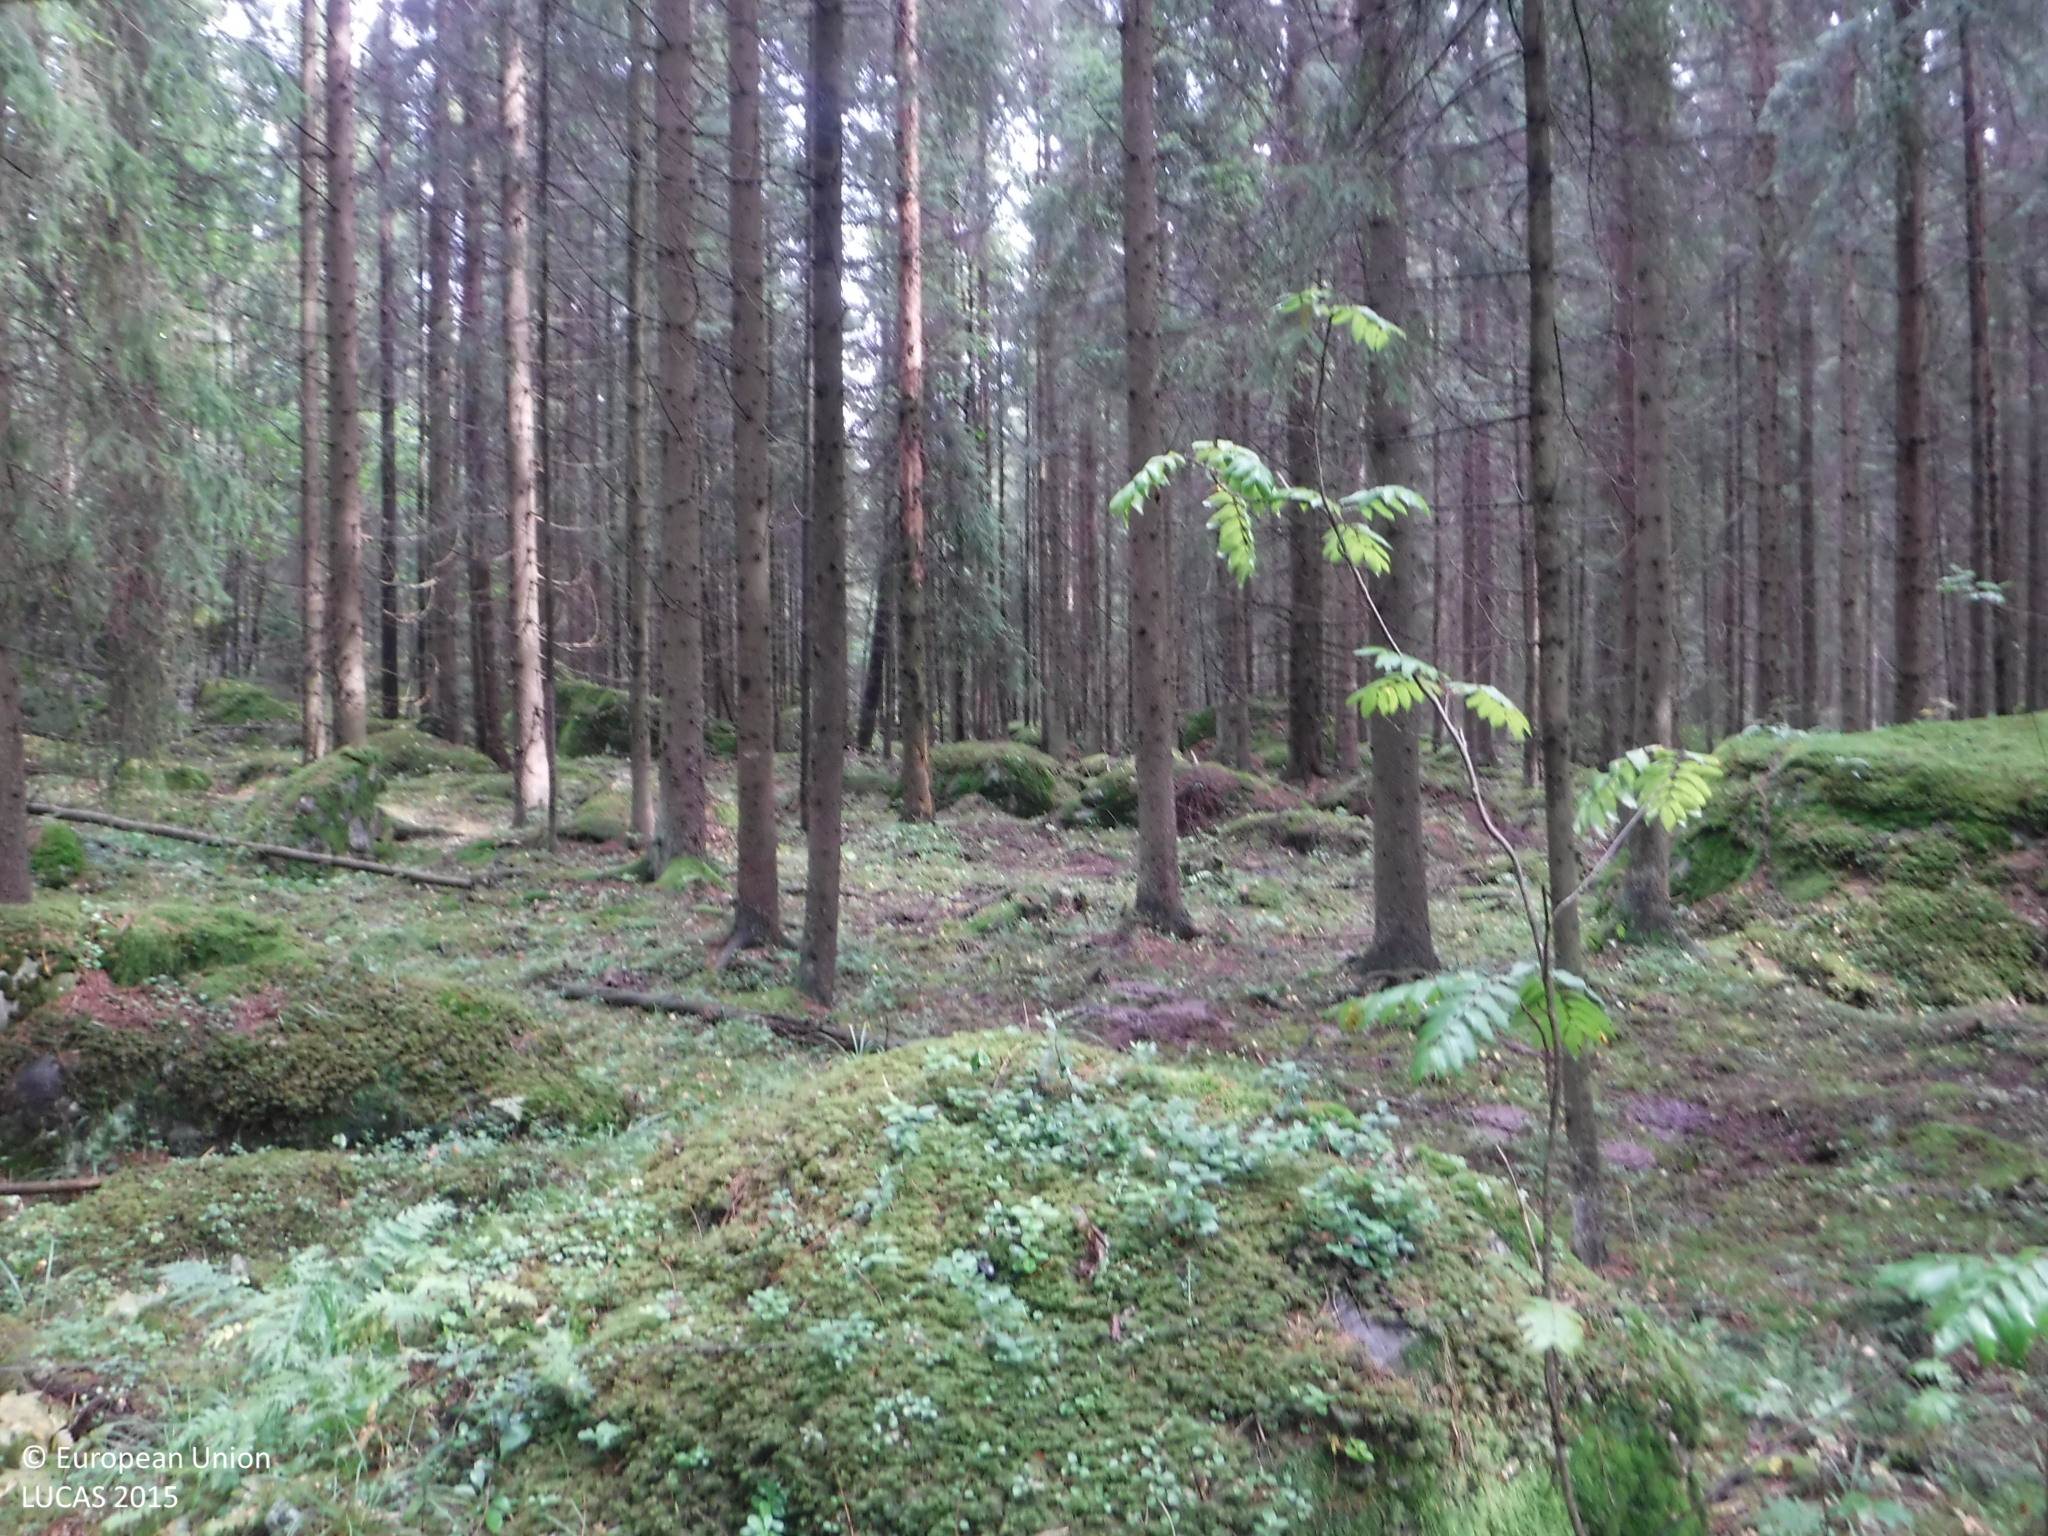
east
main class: Woodland
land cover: Spruce dominated coniferous woodland
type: boreal forest
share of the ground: 50 - 75 %
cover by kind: coniferous forest trees 60 %, lichens and mosses 25 %, shrubs 15 %
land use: Forestry
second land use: Agriculture (excluding fallow land and kitchen gardens)
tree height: > 5 m
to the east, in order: Fences; Spruce dominated coniferous woodland; Tracks; Spruce dominated coniferous woodland; Fences; Spruce dominated coniferous woodland
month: September
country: FI
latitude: 61.2921
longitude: 23.2334
